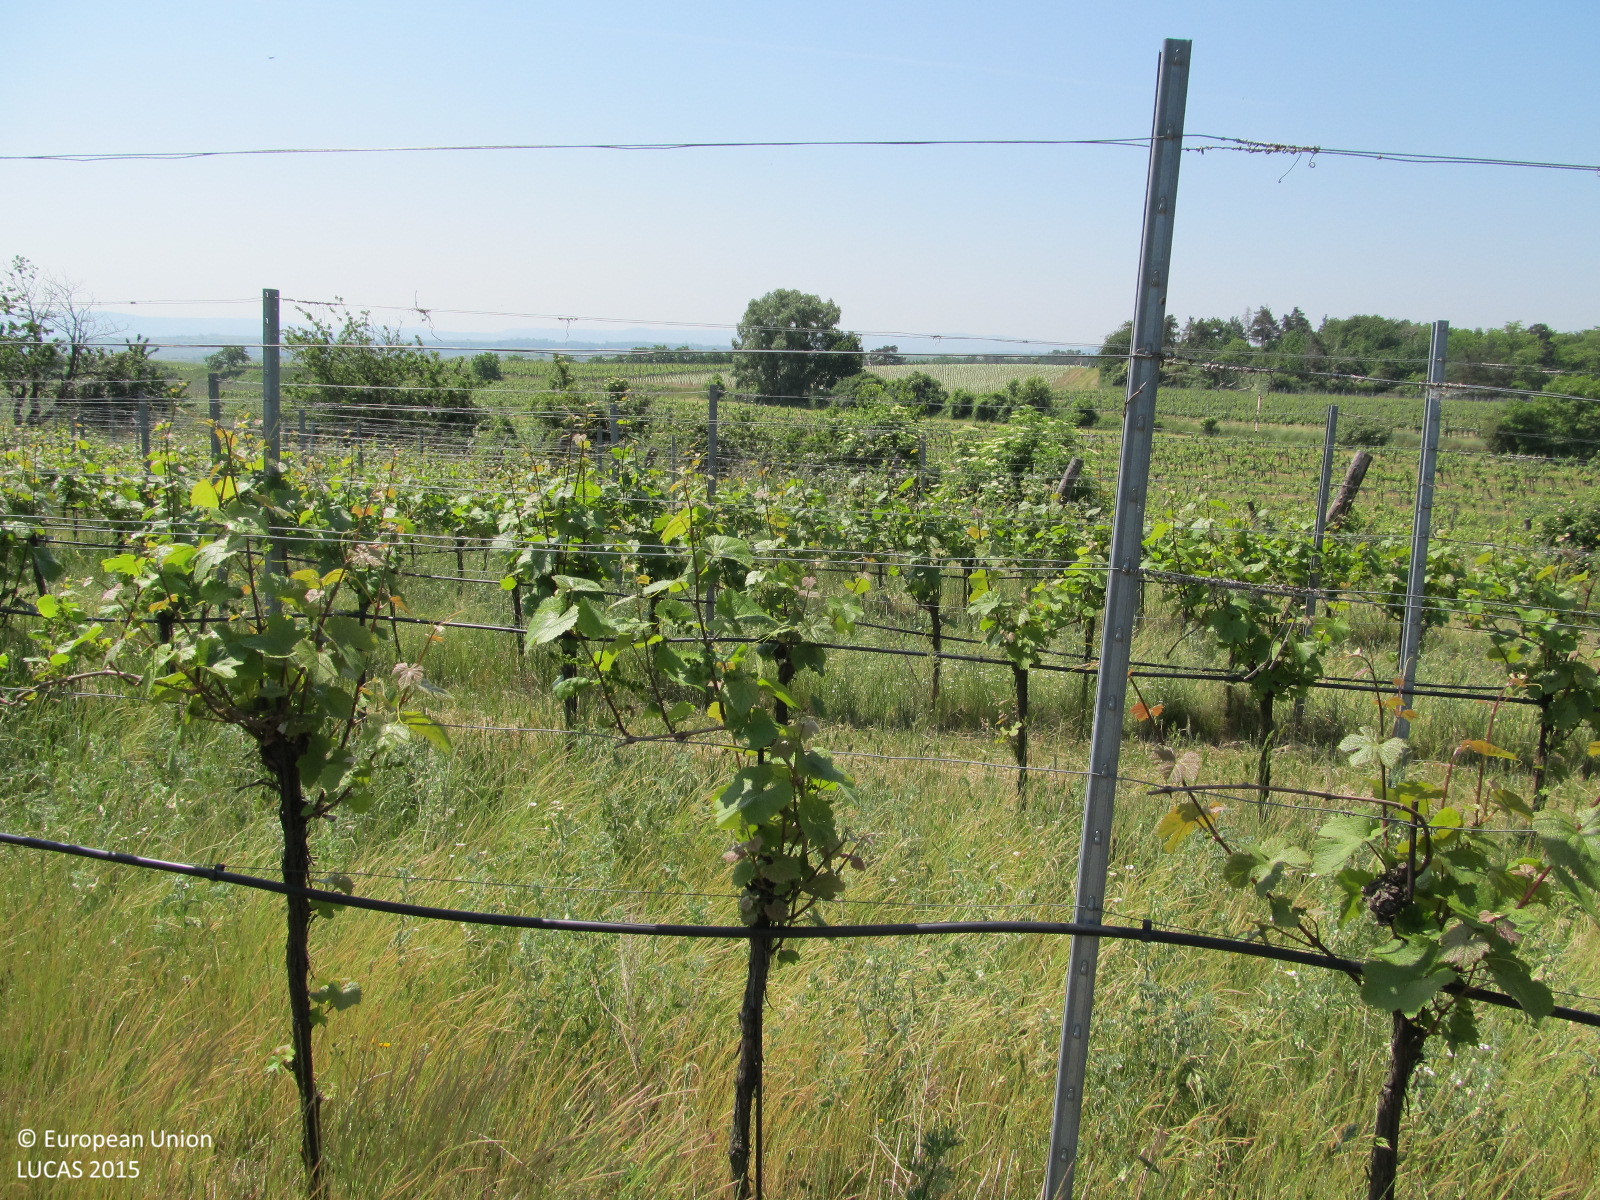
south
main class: Cropland
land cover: Vineyards
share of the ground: 10 - 25 %
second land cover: Grassland without tree/shrub cover
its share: > 75 %
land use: Agriculture (excluding fallow land and kitchen gardens)
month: May
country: AT
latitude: 48.4937
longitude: 15.6460
